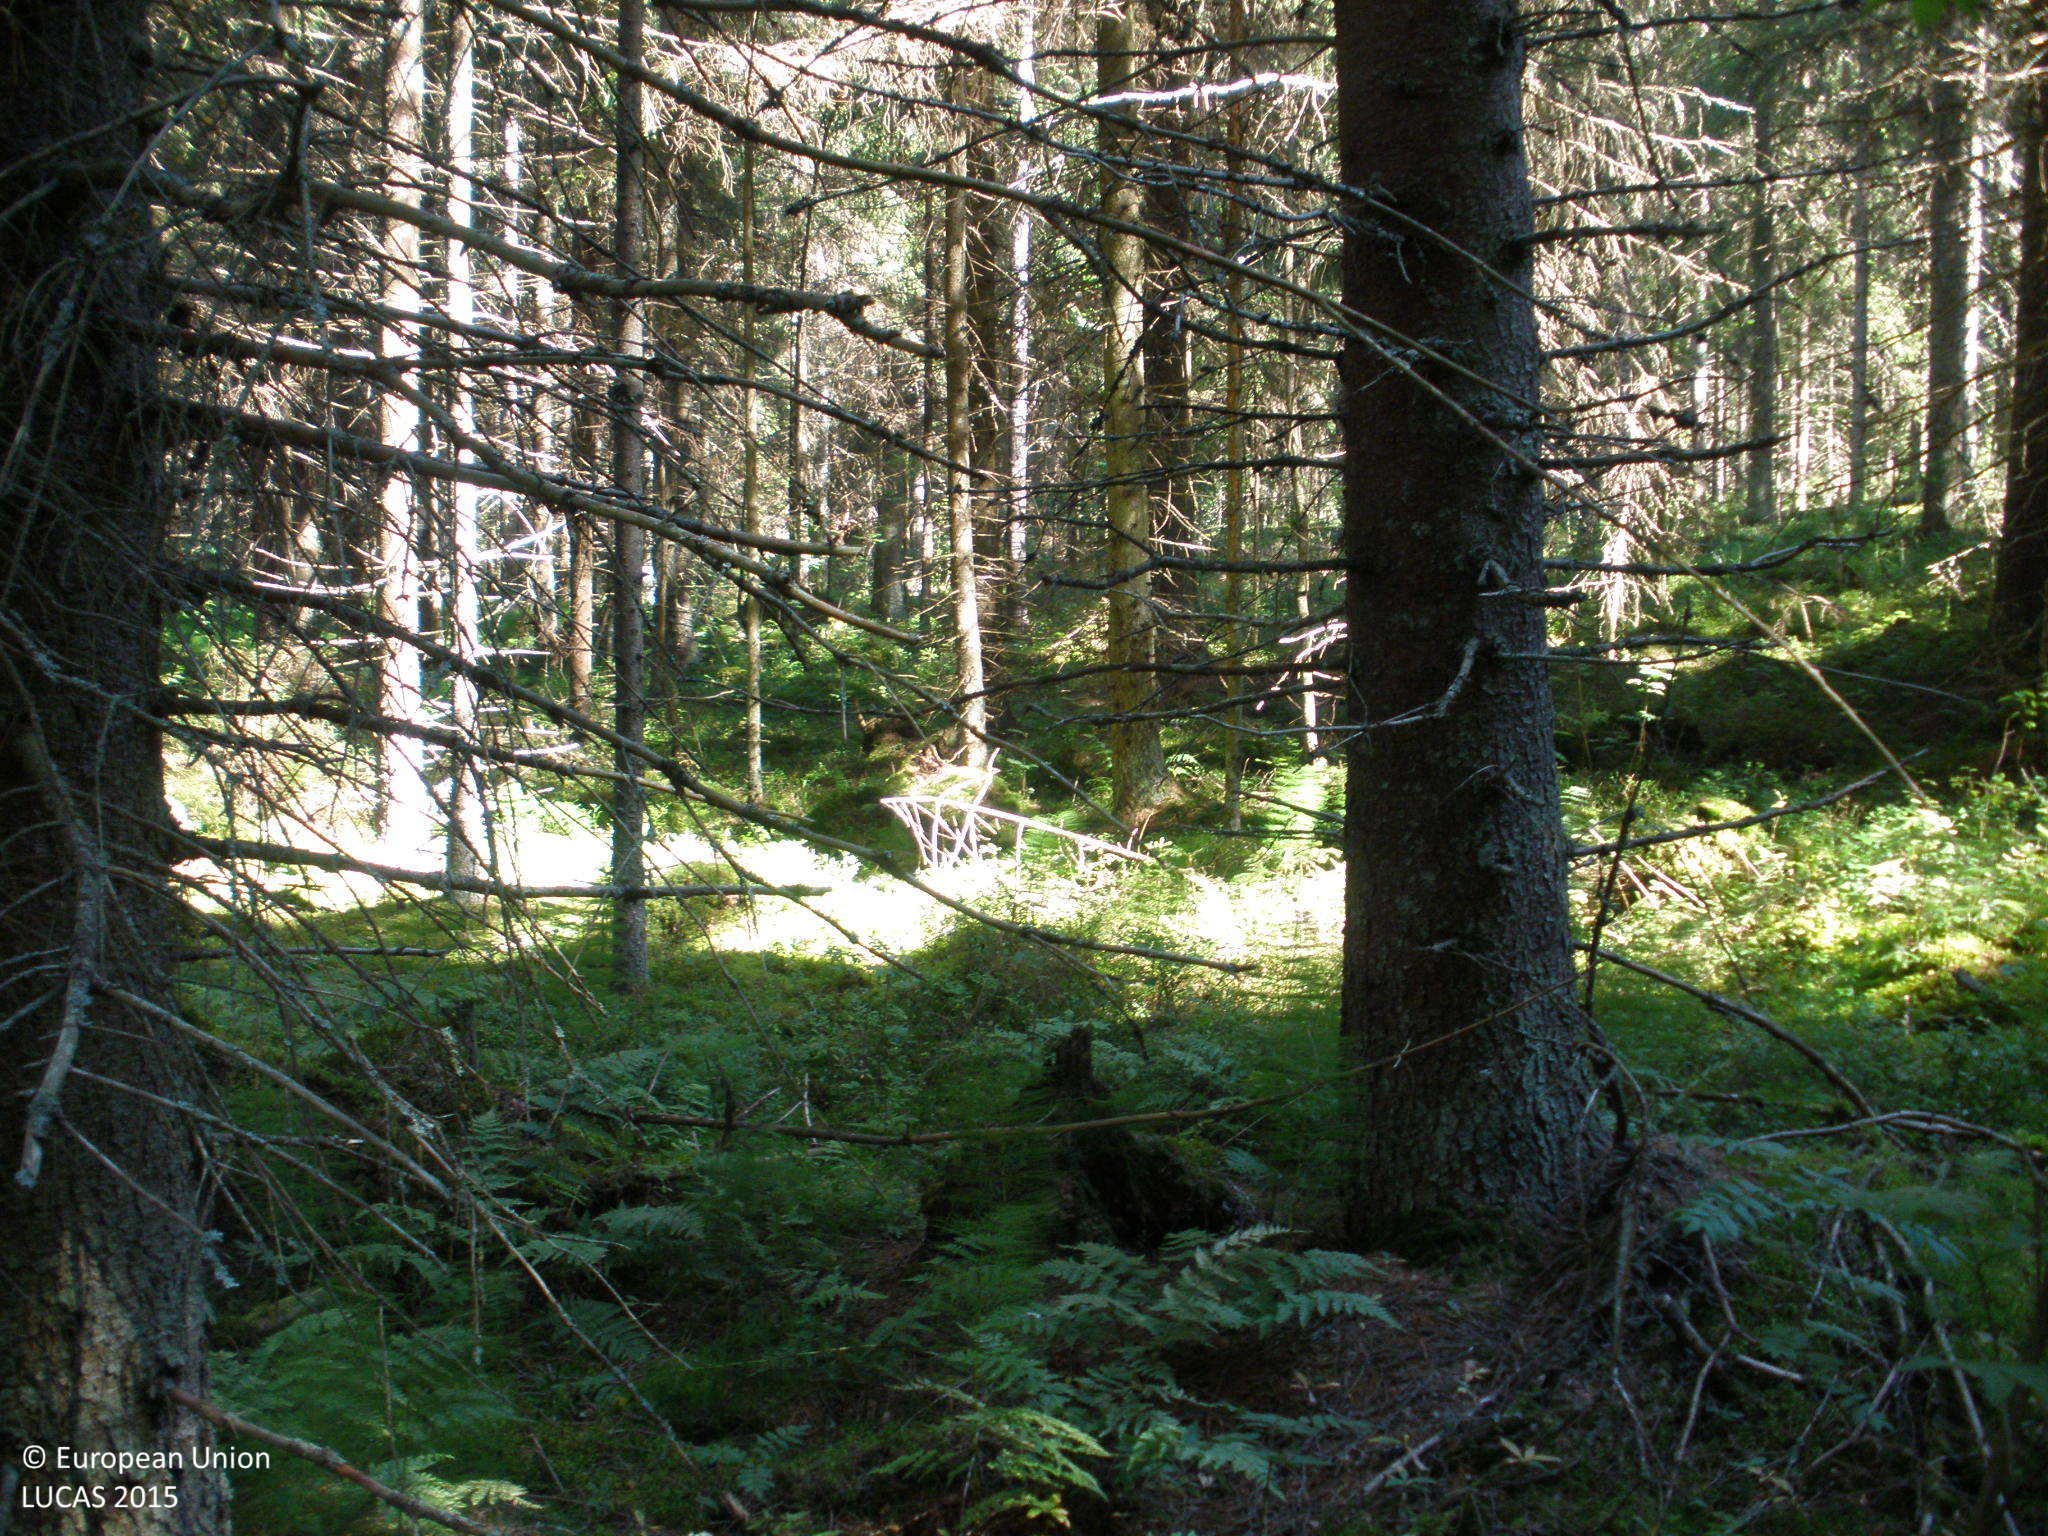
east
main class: Woodland
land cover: Spruce dominated coniferous woodland
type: boreal forest
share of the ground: > 75 %
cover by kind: coniferous forest trees 90 %, herbaceous plants 5 %, lichens and mosses 5 %
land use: Forestry
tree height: > 5 m
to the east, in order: Spruce dominated coniferous woodland; Spruce dominated mixed woodland; Temporary grasslands
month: August
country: FI
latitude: 60.8177
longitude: 24.3497
